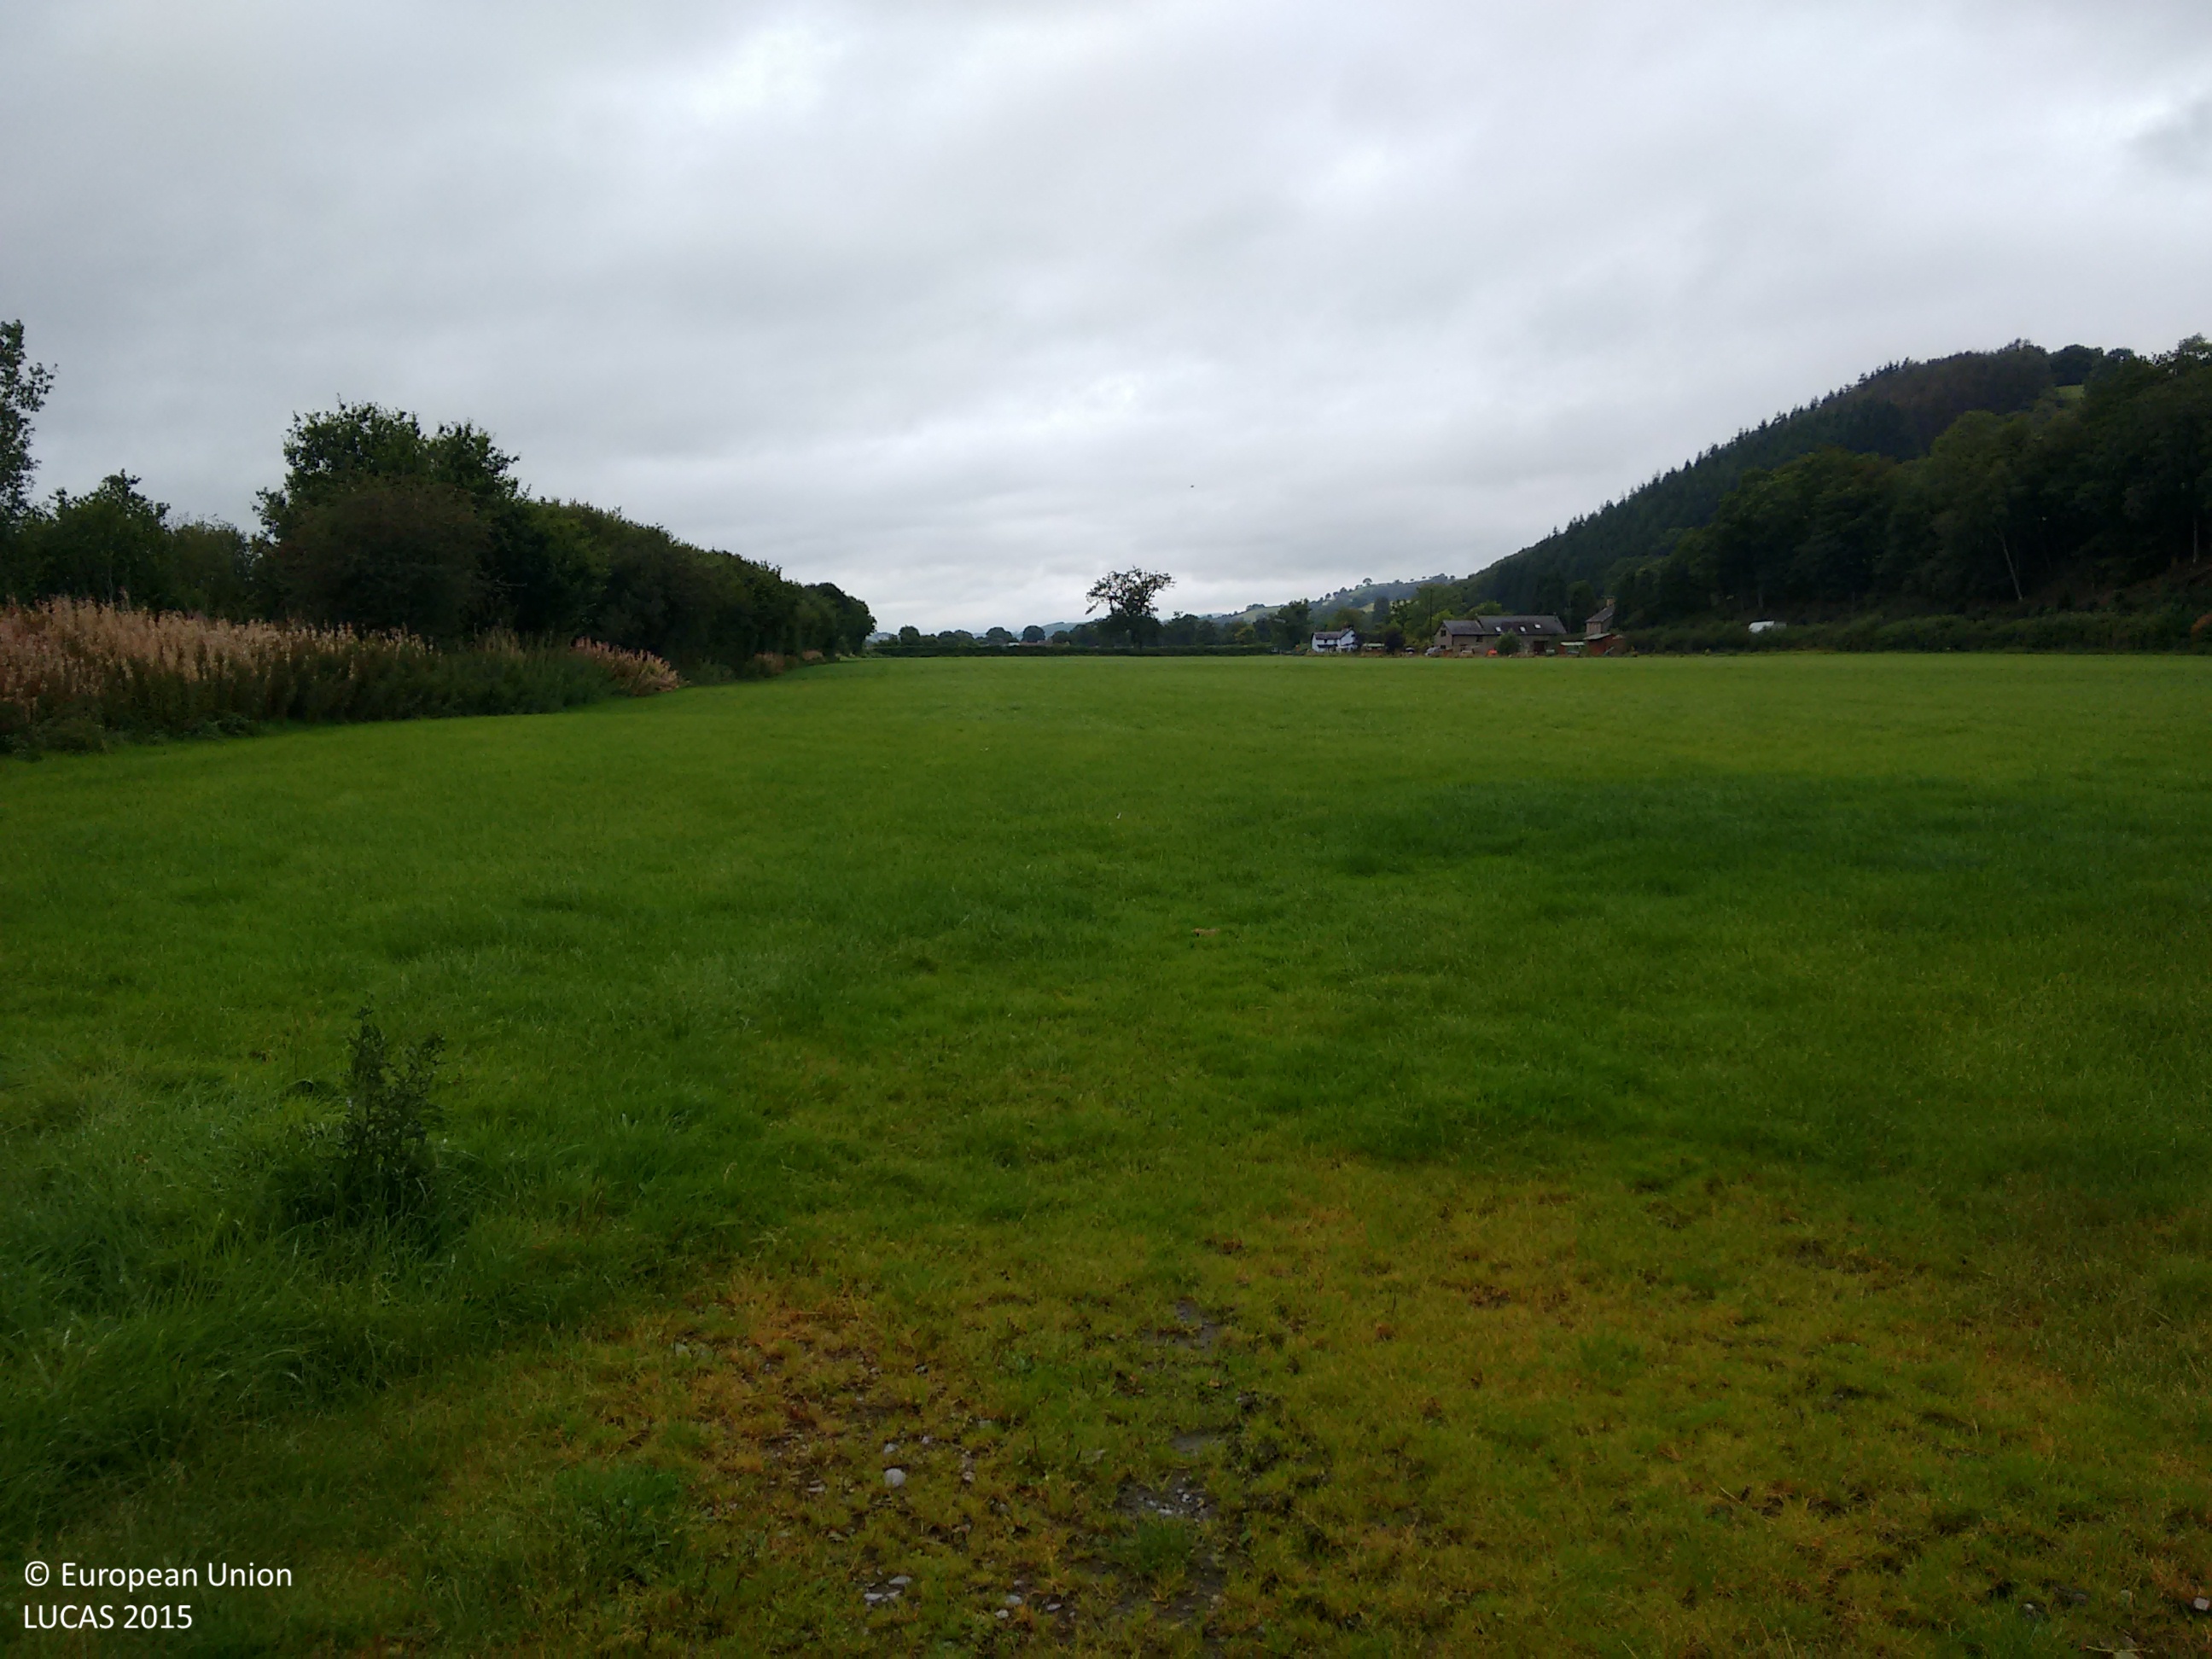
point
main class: Grassland
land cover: Grassland without tree/shrub cover
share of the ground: > 75 %
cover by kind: herbaceous plants 100 %
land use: Agriculture (excluding fallow land and kitchen gardens)
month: September
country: GB
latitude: 51.9836
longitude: -3.8214
